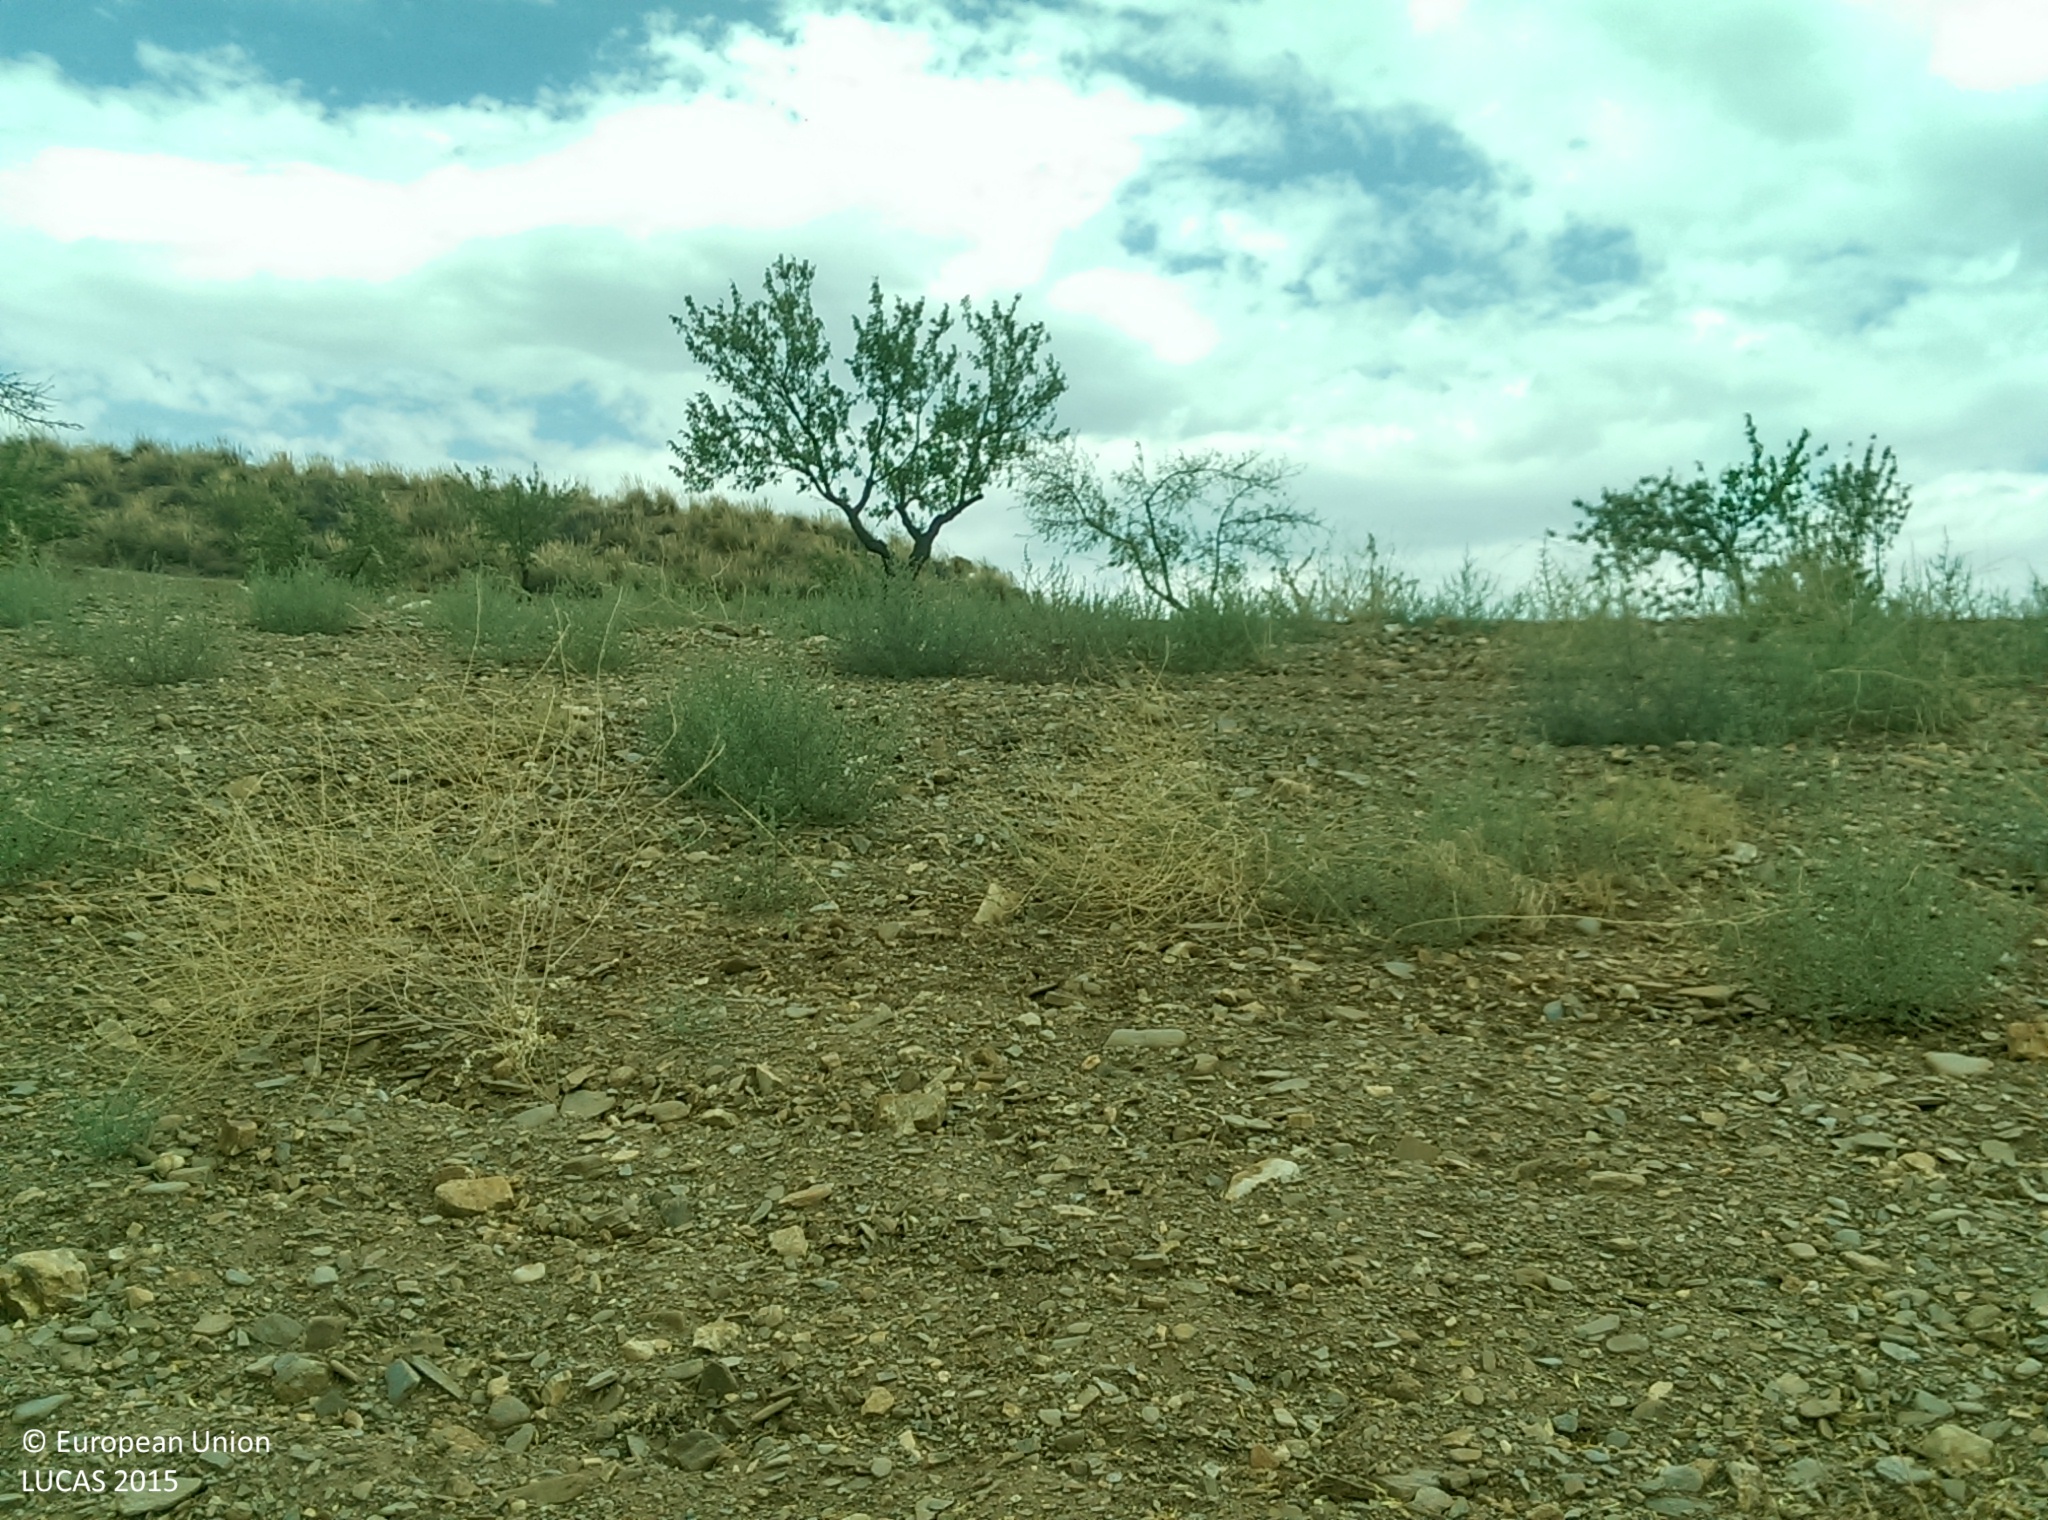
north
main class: Cropland
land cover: Nuts trees
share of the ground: < 10 %
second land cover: Spontaneously vegetated surfaces
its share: 10 - 25 %
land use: Agriculture (excluding fallow land and kitchen gardens)
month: July
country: ES
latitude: 37.1943
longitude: -2.9054
